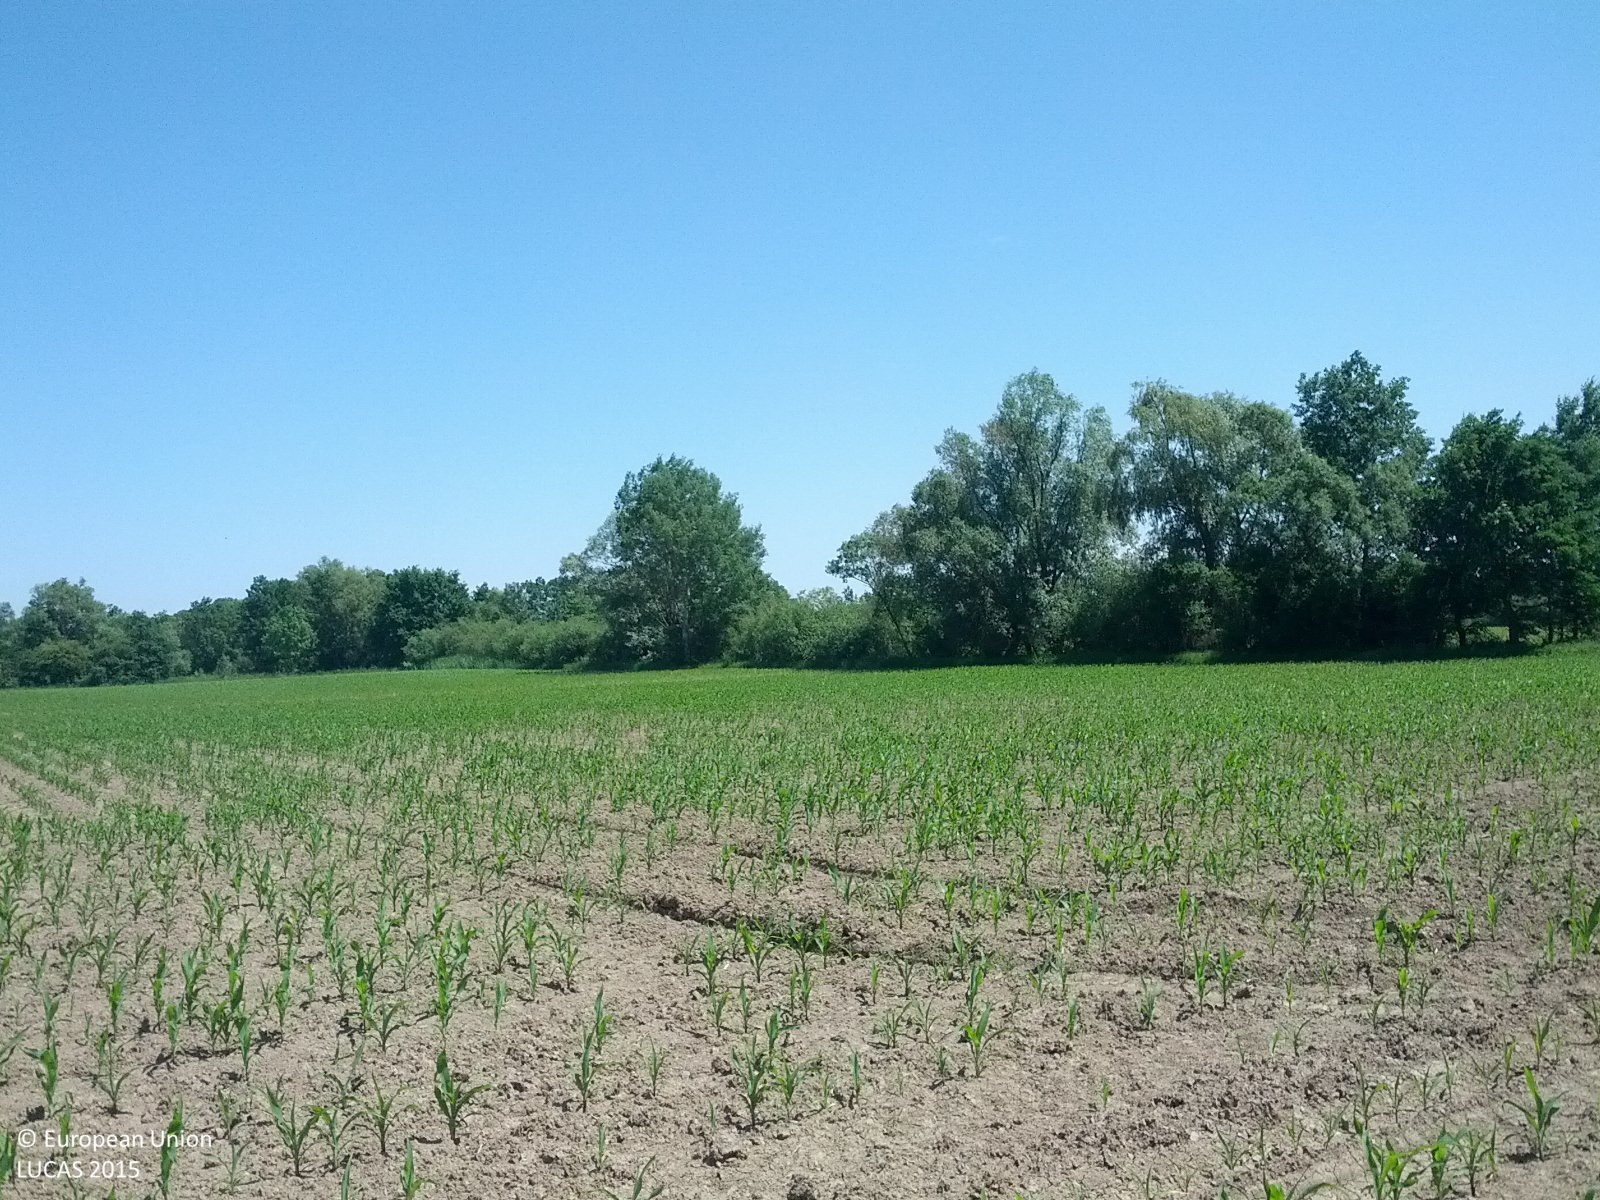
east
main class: Cropland
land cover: Maize
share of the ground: 10 - 25 %
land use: Agriculture (excluding fallow land and kitchen gardens)
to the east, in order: Maize; Grass margins; Ditches and canals; Broadleaved woodland; Grass margins; Maize; Grass margins; Tracks; Broadleaved woodland; Inland fresh running water; Broadleaved woodland; Tracks
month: June
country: AT
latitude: 47.0679
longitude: 16.3094
